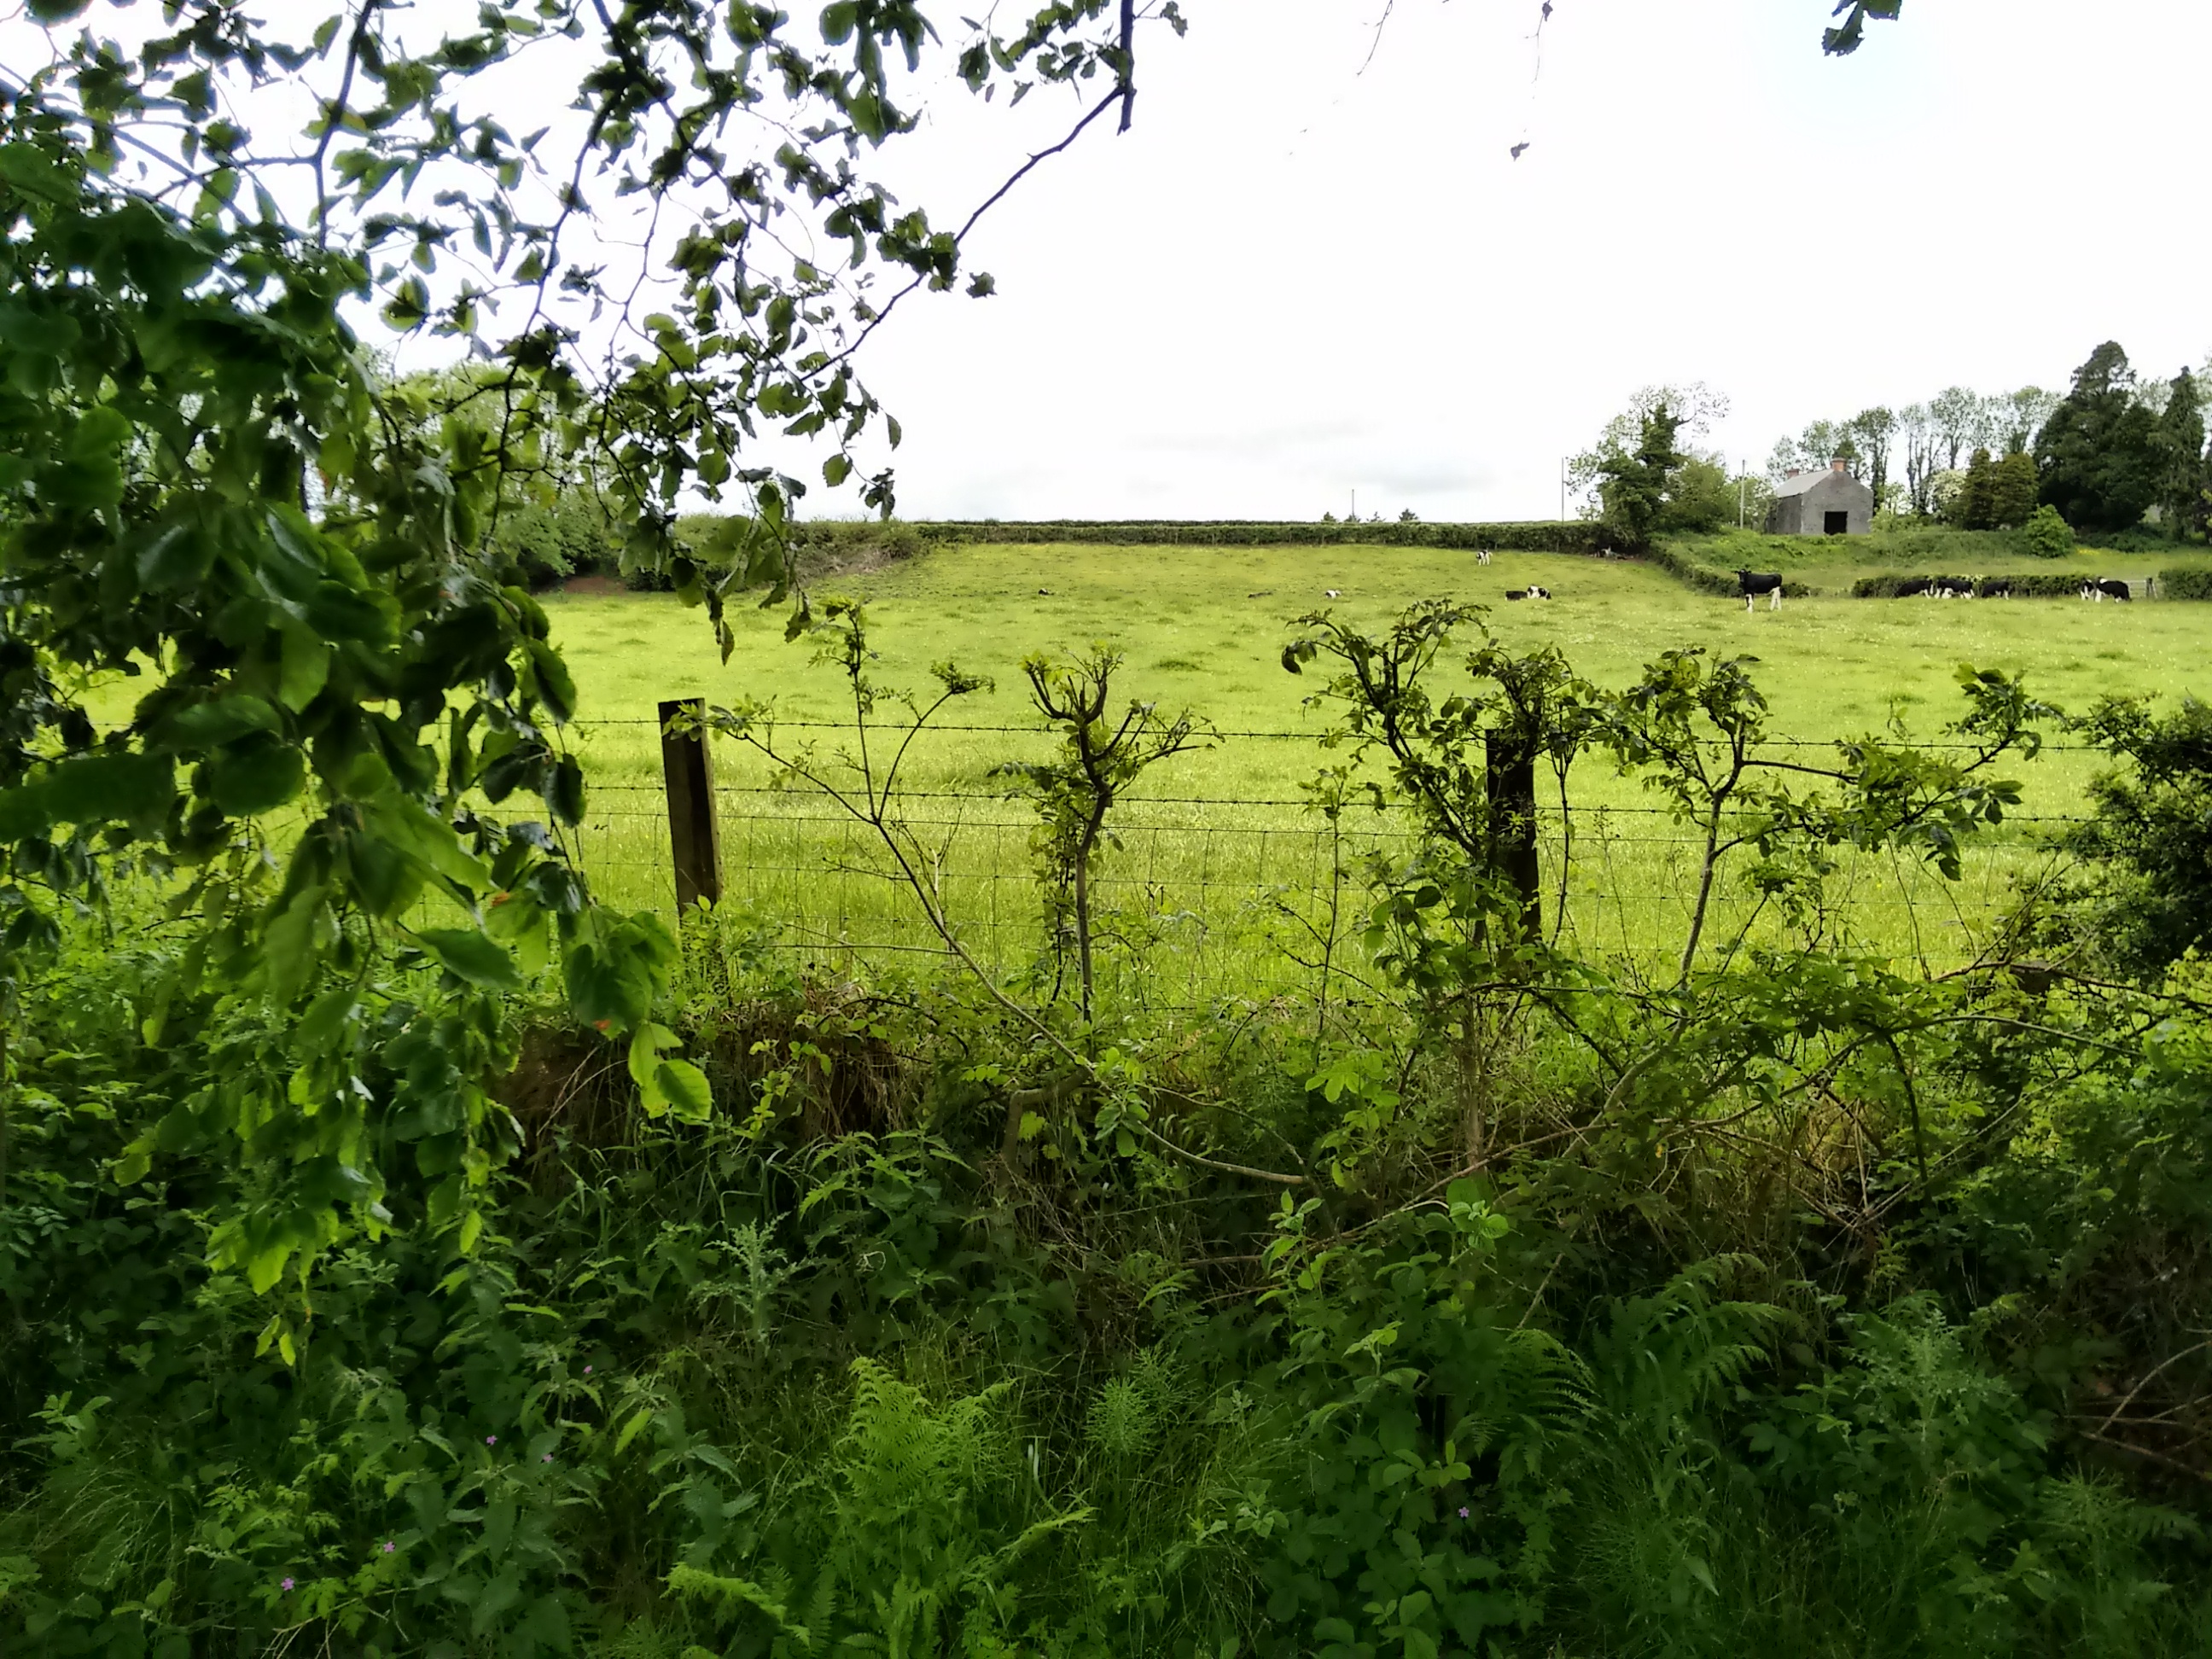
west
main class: Grassland
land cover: Grassland without tree/shrub cover
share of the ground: > 75 %
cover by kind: herbaceous plants 100 %
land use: Agriculture (excluding fallow land and kitchen gardens)
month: June
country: GB
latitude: 54.9480
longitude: -6.5972
